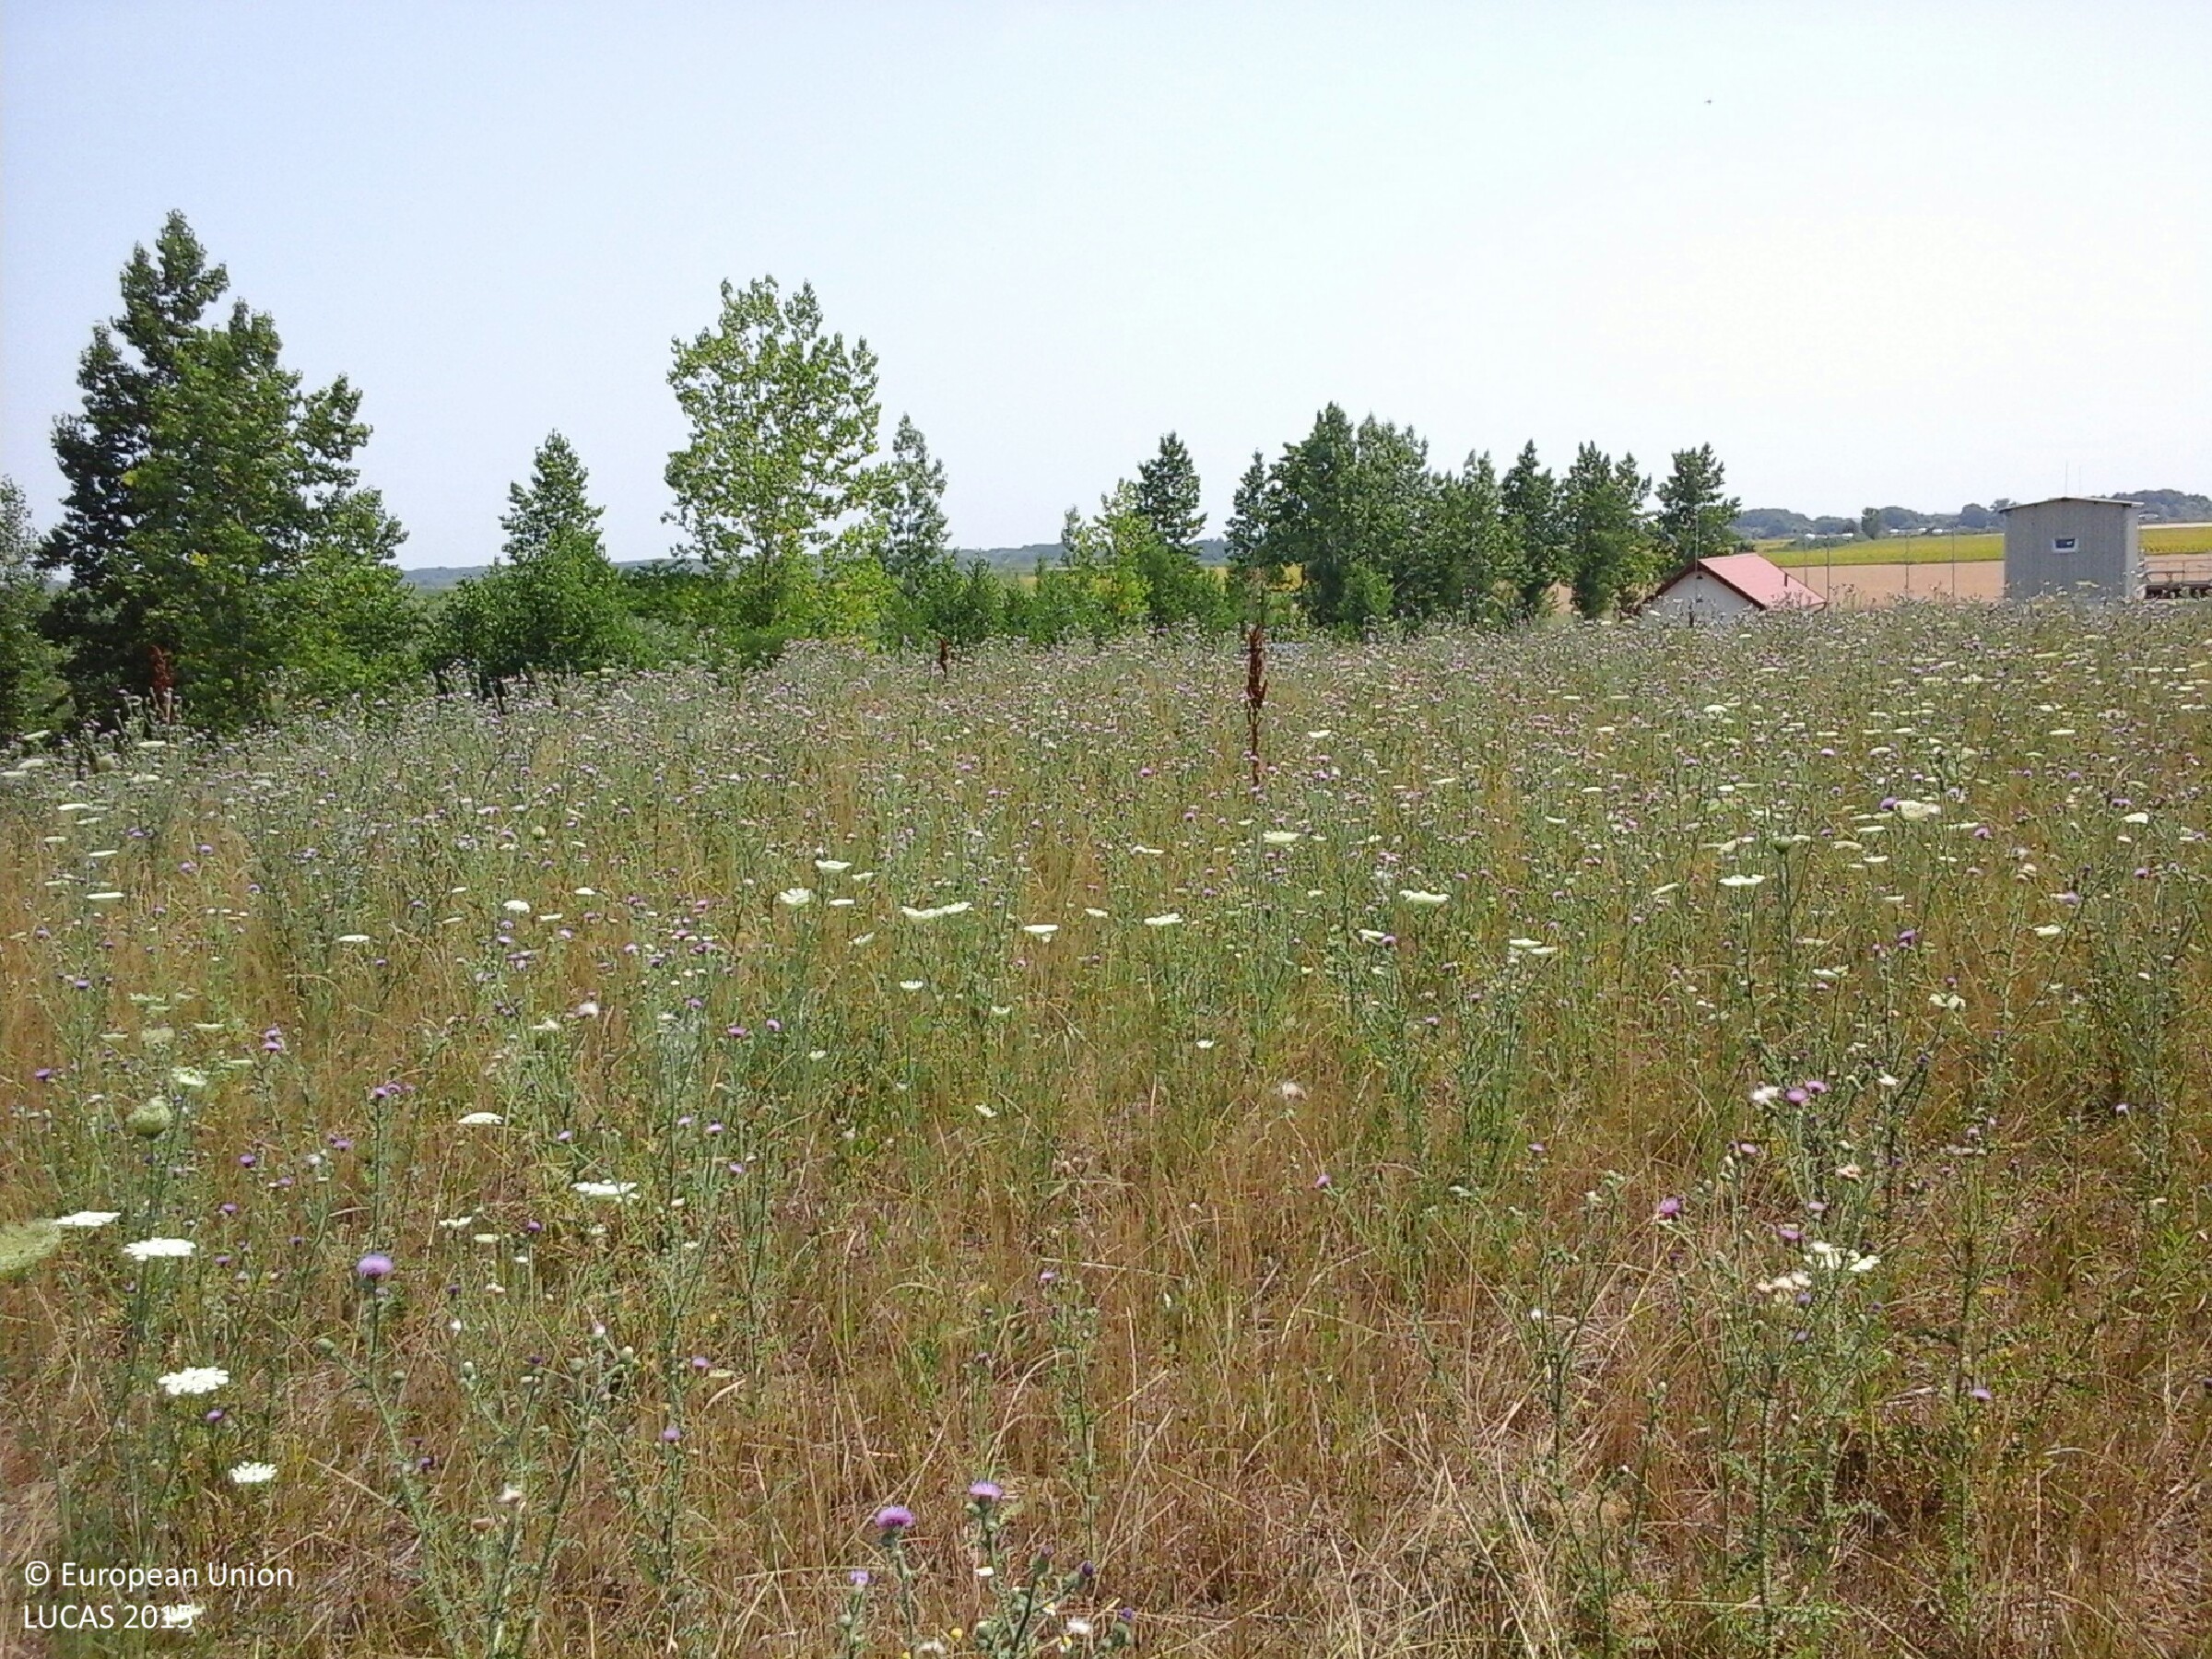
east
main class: Artificial land
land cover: Other artificial areas
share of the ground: > 75 %
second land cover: Spontaneously vegetated surfaces
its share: > 75 %
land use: Waste treatment
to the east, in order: Artificial constructions in urban areas; Spontaneously vegetated surfaces; Paved roads, cycling and walking lanes; Broadleaved woodland; Grassland with sparse tree/shrub cover; Tracks; Shrubland with sparse tree cover; Inland fresh running water; Shrubland with sparse tree cover; Inland fresh running water; Shrubland with sparse tree cover; Common wheat
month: July
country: HU
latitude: 48.0144
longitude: 21.0189
